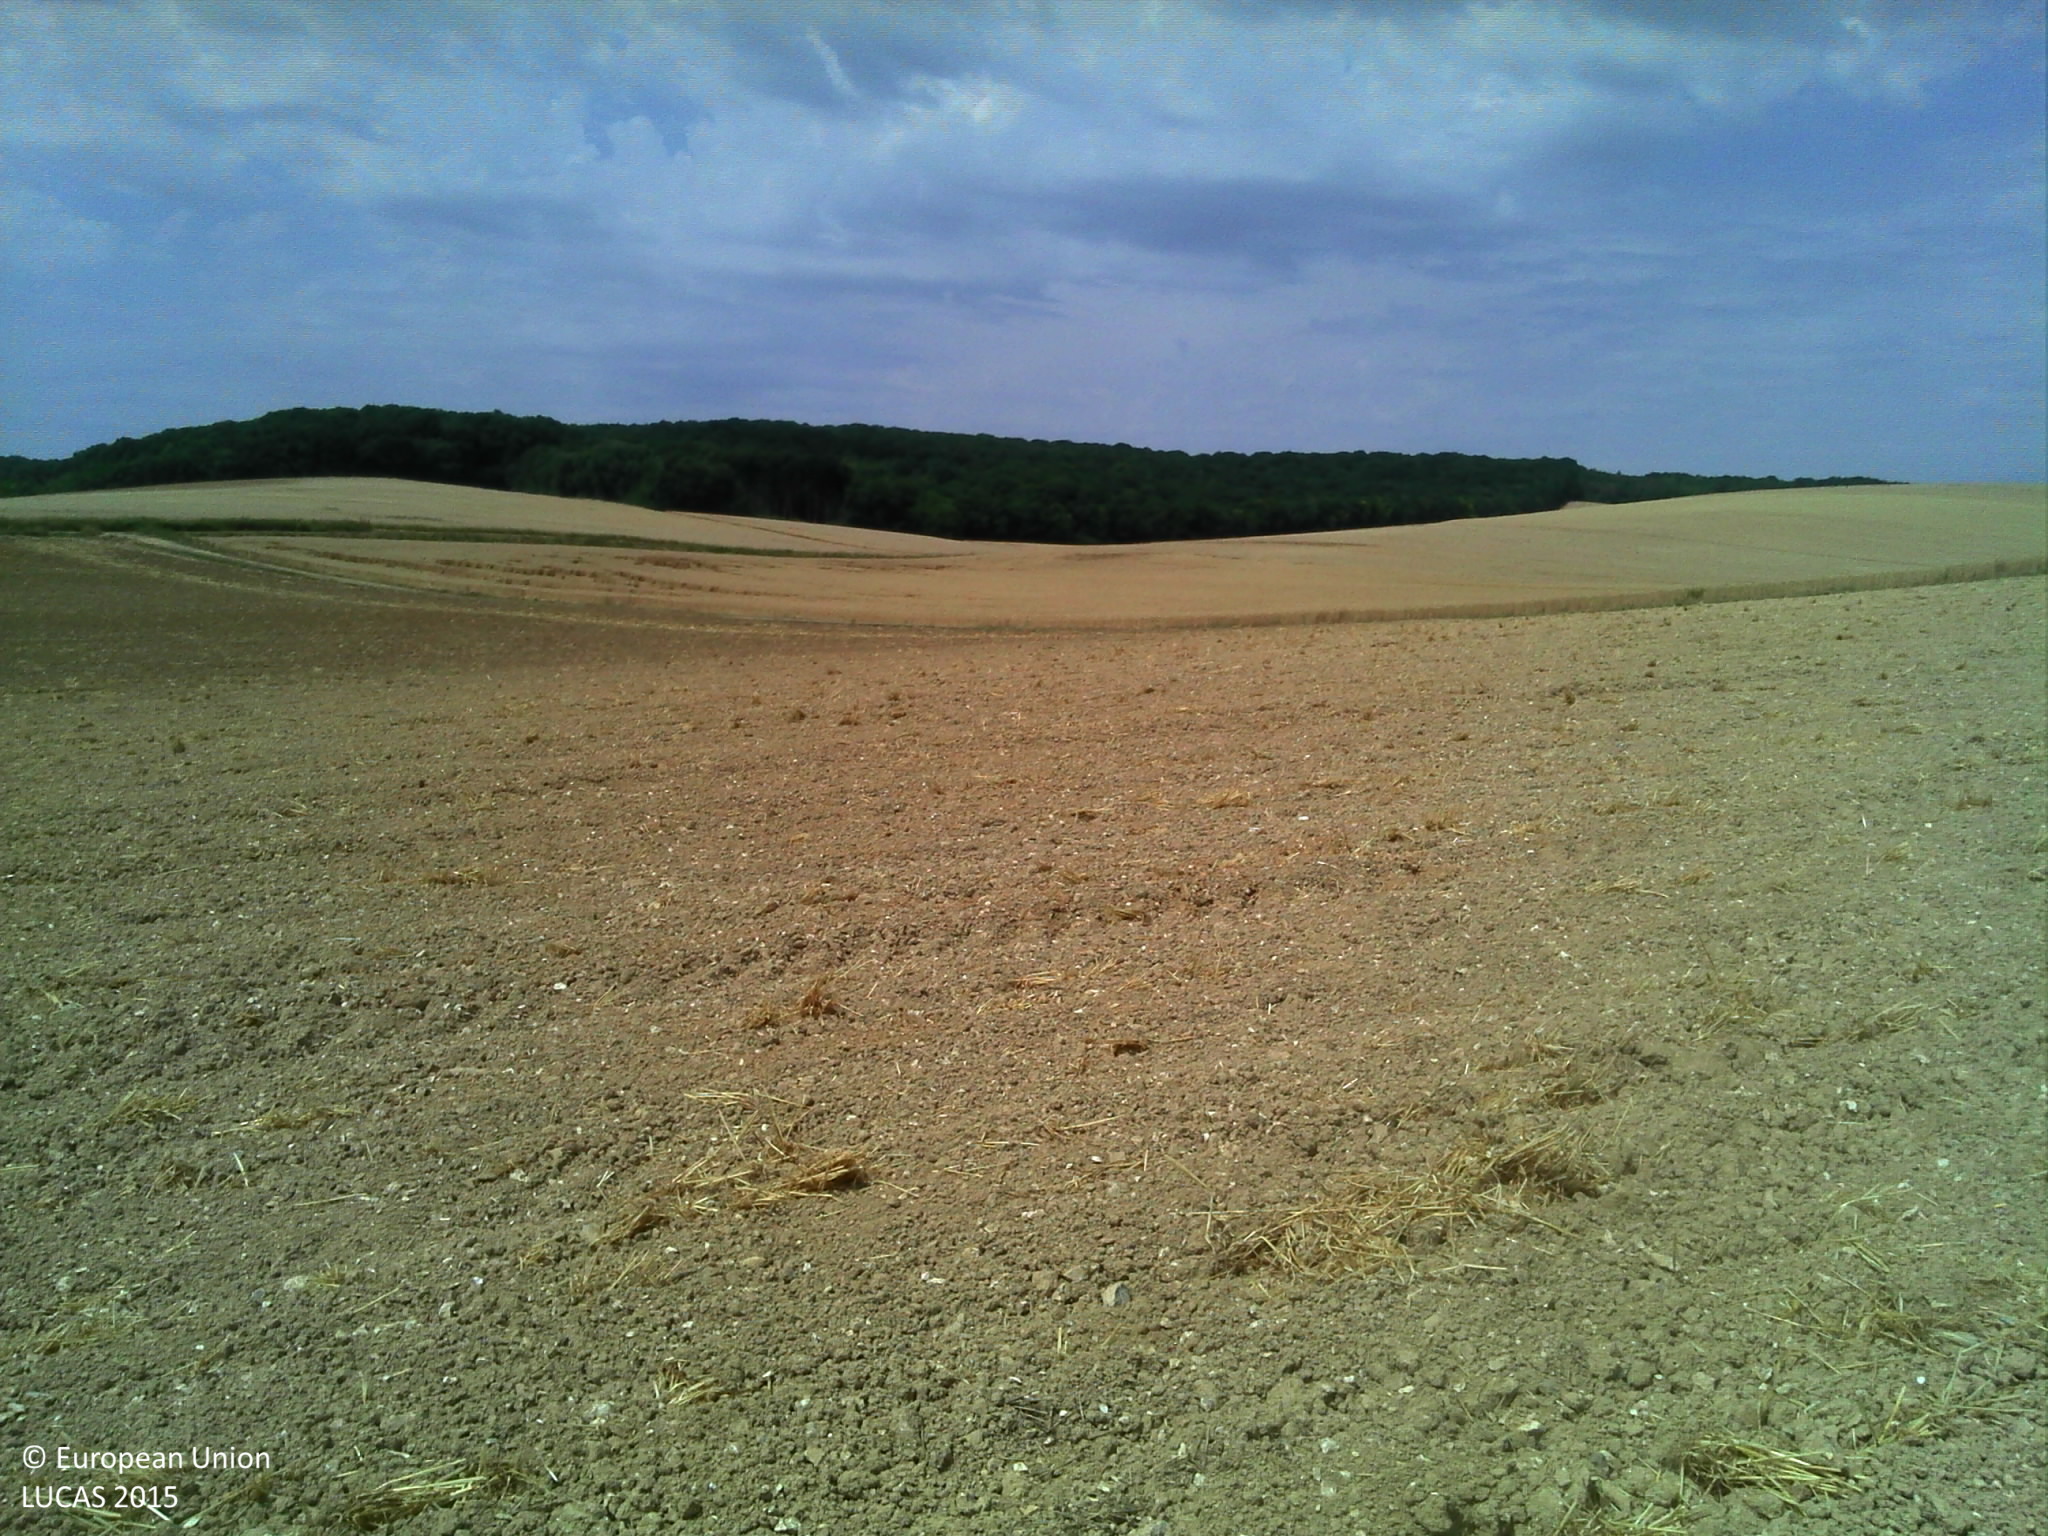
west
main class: Cropland
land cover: Barley
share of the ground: > 75 %
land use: Agriculture (excluding fallow land and kitchen gardens)
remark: Harvested field
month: July
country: FR
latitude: 48.2298
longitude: 3.4921
